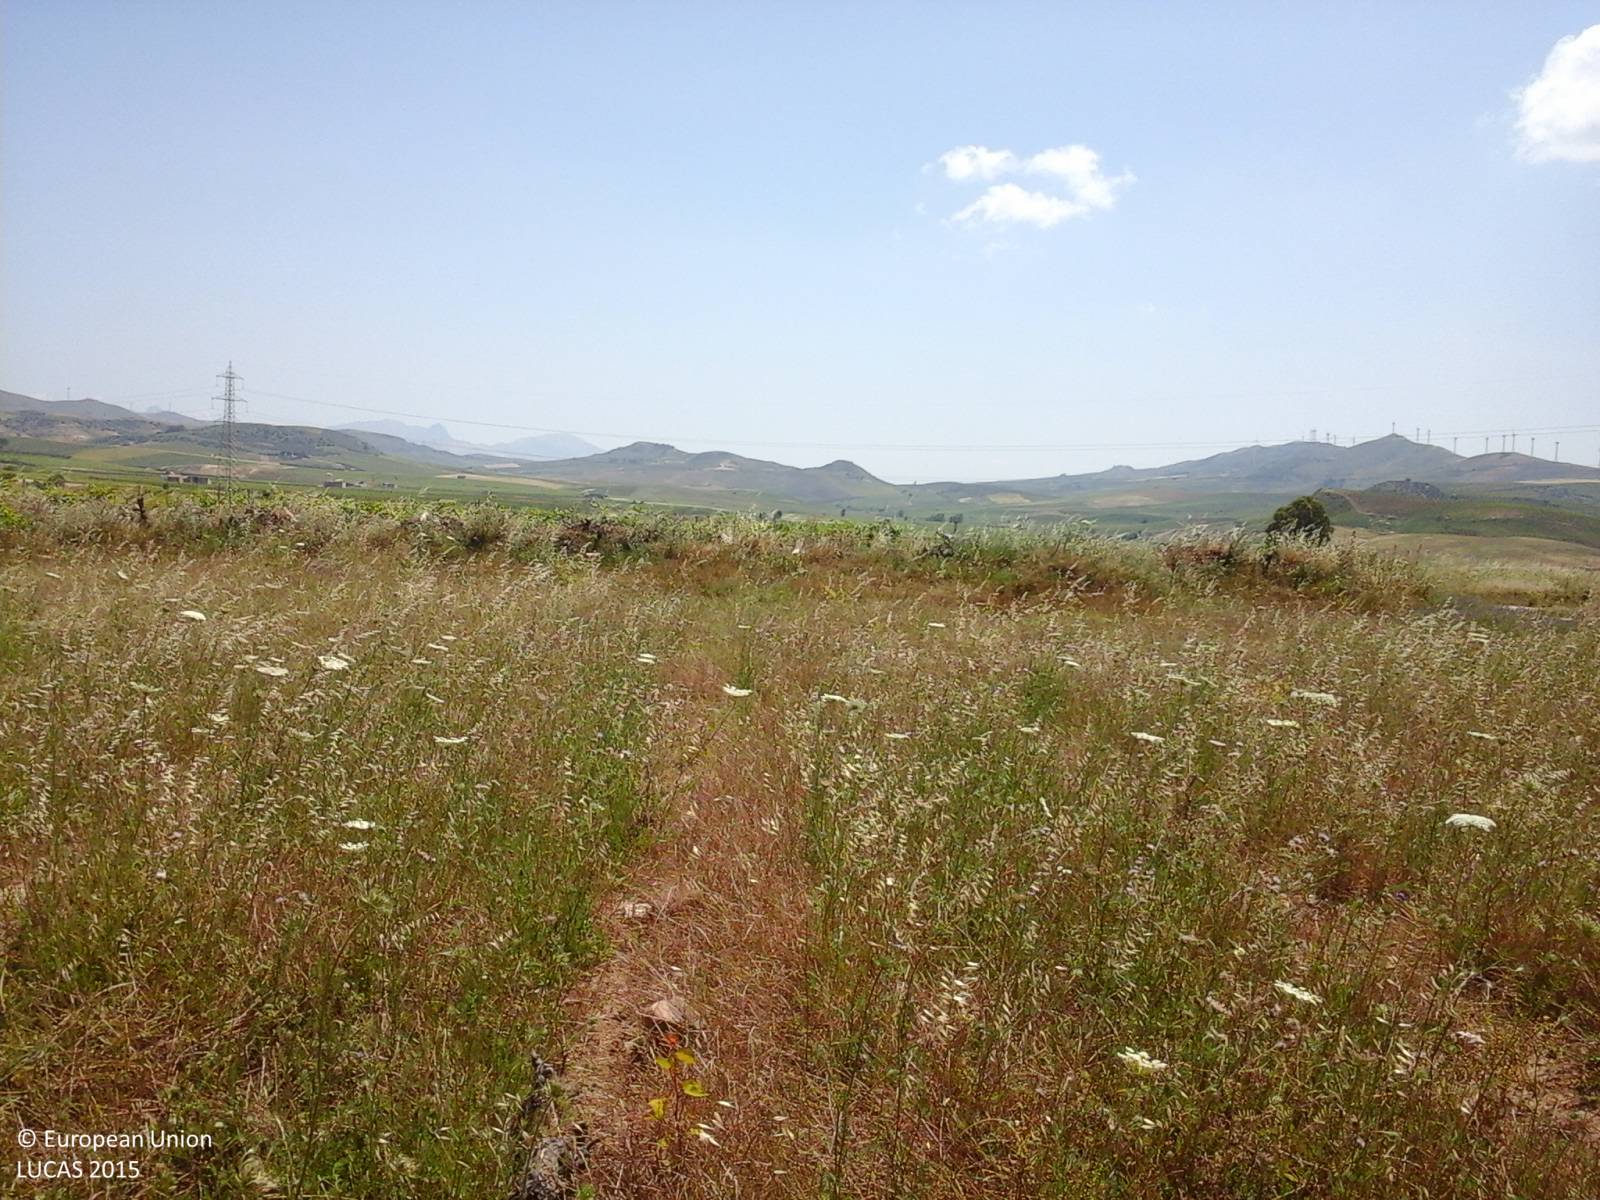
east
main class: Grassland
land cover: Grassland without tree/shrub cover
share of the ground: > 75 %
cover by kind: herbaceous plants 100 %
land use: Abandoned areas
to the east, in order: Grassland without tree/shrub cover; Grass margins; Paved roads, cycling and walking lanes; Vineyards; Grassland without tree/shrub cover
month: June
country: IT
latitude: 37.9184
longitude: 12.9927
